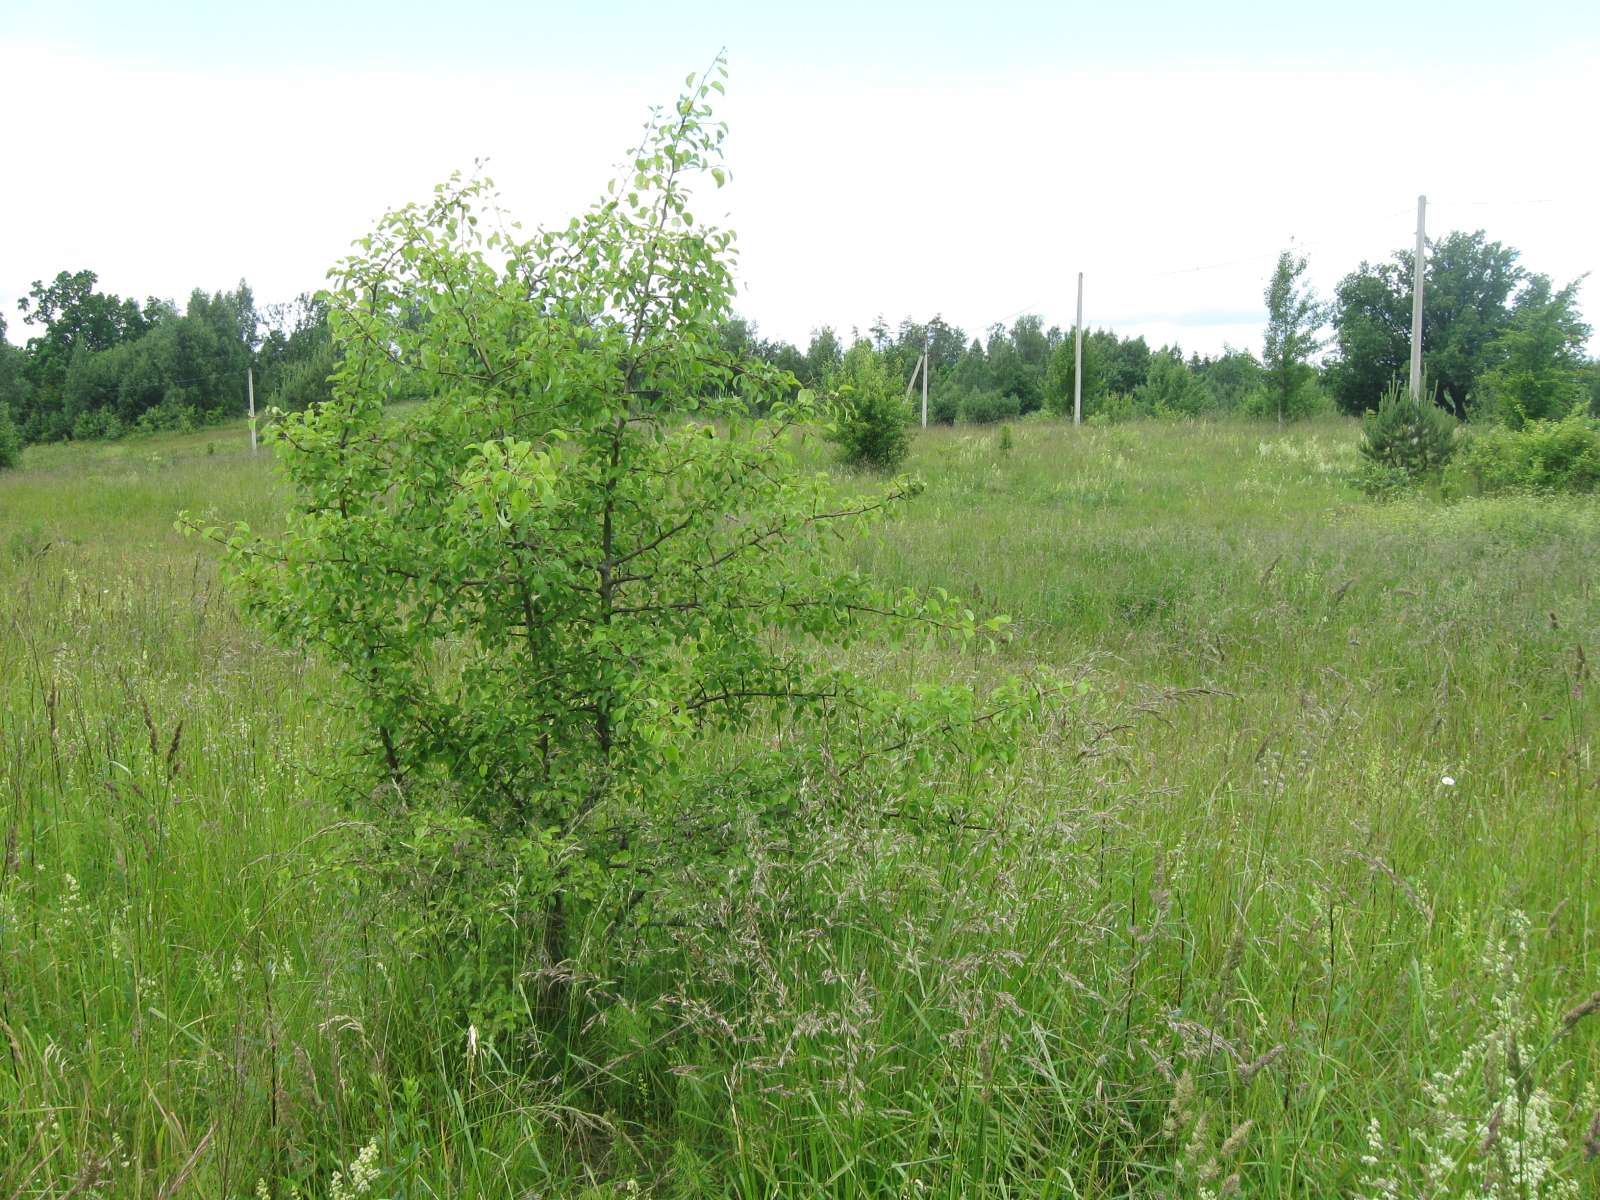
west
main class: Grassland
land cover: Grassland with sparse tree/shrub cover
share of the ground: > 75 %
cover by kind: herbaceous plants 90 %, broadleaved forest trees 5 %, shrubs 5 %
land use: Agriculture (excluding fallow land and kitchen gardens)
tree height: < 5 m
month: June
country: LT
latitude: 54.5076
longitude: 24.4180
